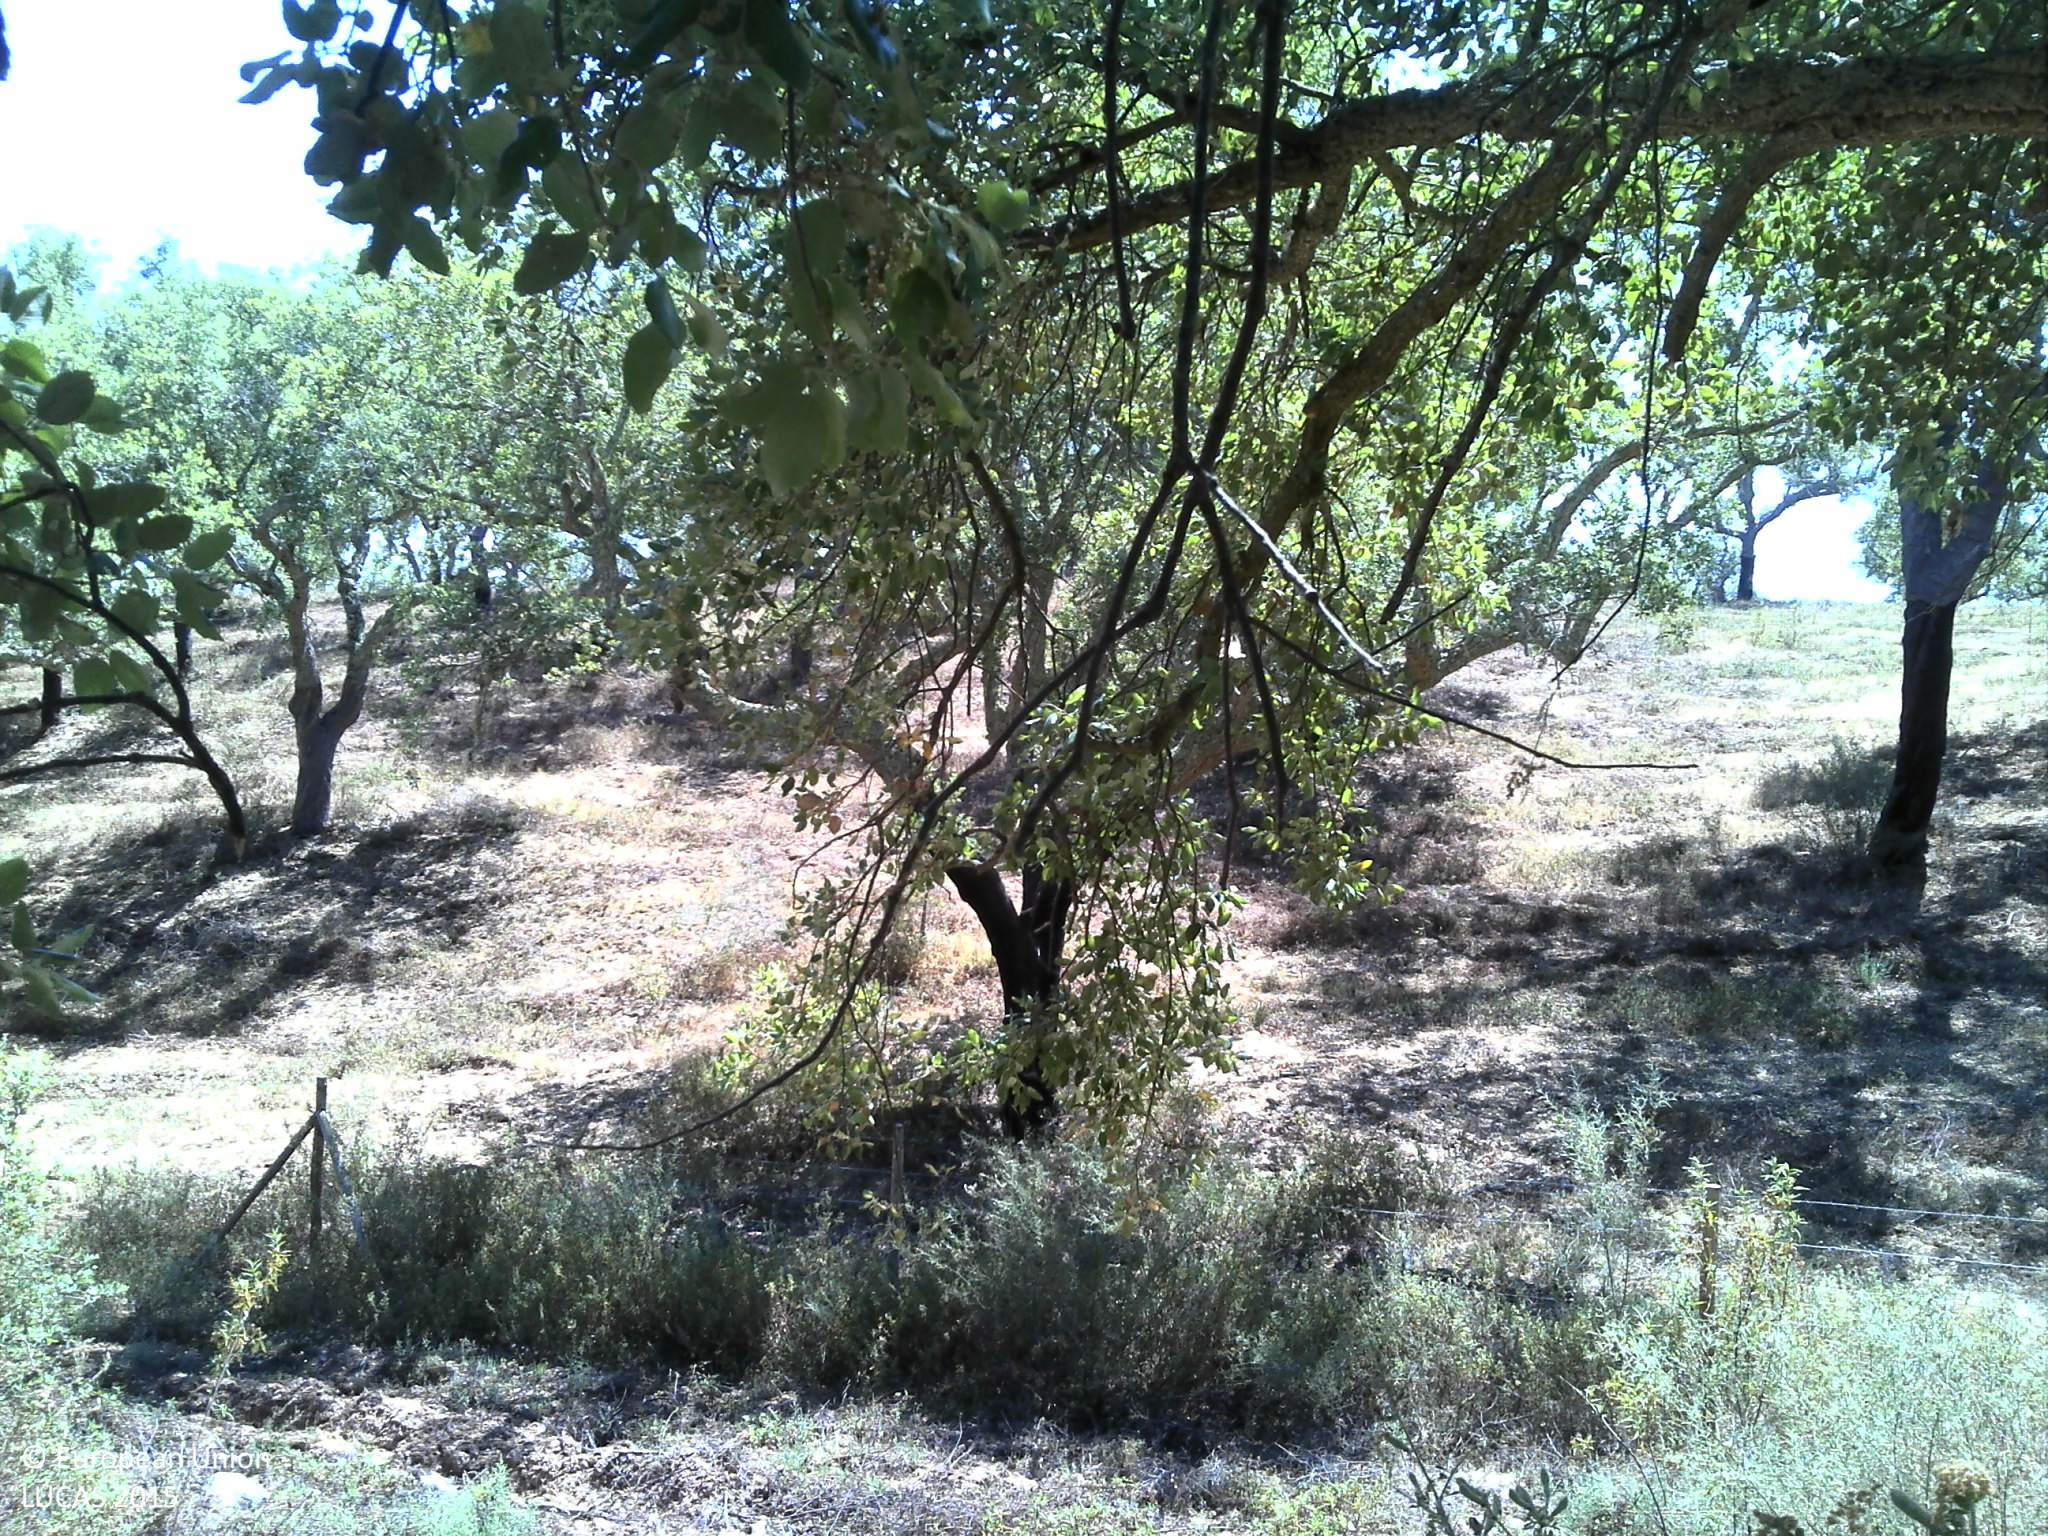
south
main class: Woodland
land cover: Broadleaved woodland
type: broadleaved evergreen forest
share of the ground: 25 - 50 %
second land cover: Grassland without tree/shrub cover
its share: 10 - 25 %
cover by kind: broadleaved forest trees 50 %, unconsolidated bare surface 35 %, herbaceous plants 15 %
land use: Forestry
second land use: Agriculture (excluding fallow land and kitchen gardens)
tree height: > 5 m
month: June
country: PT
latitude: 38.7851
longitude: -7.7332
